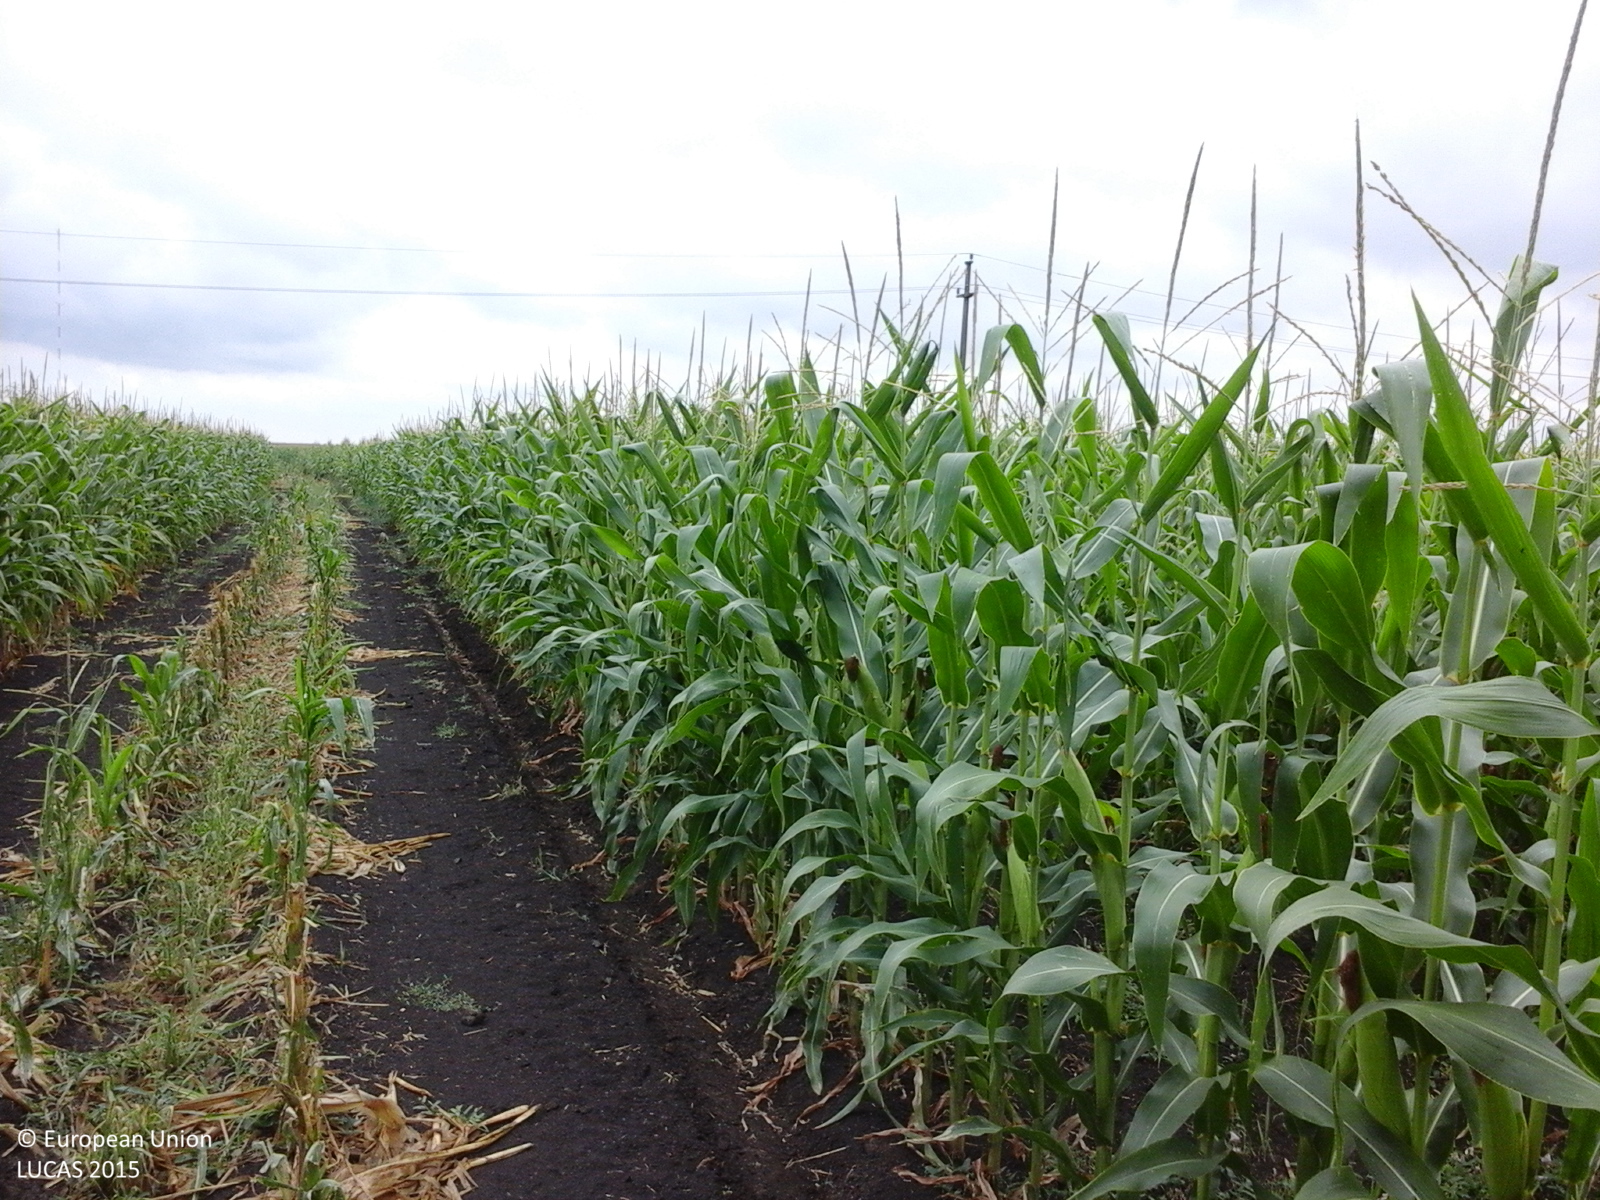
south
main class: Cropland
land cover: Maize
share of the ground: > 75 %
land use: Agriculture (excluding fallow land and kitchen gardens)
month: August
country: RO
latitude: 46.0527
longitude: 20.6631
